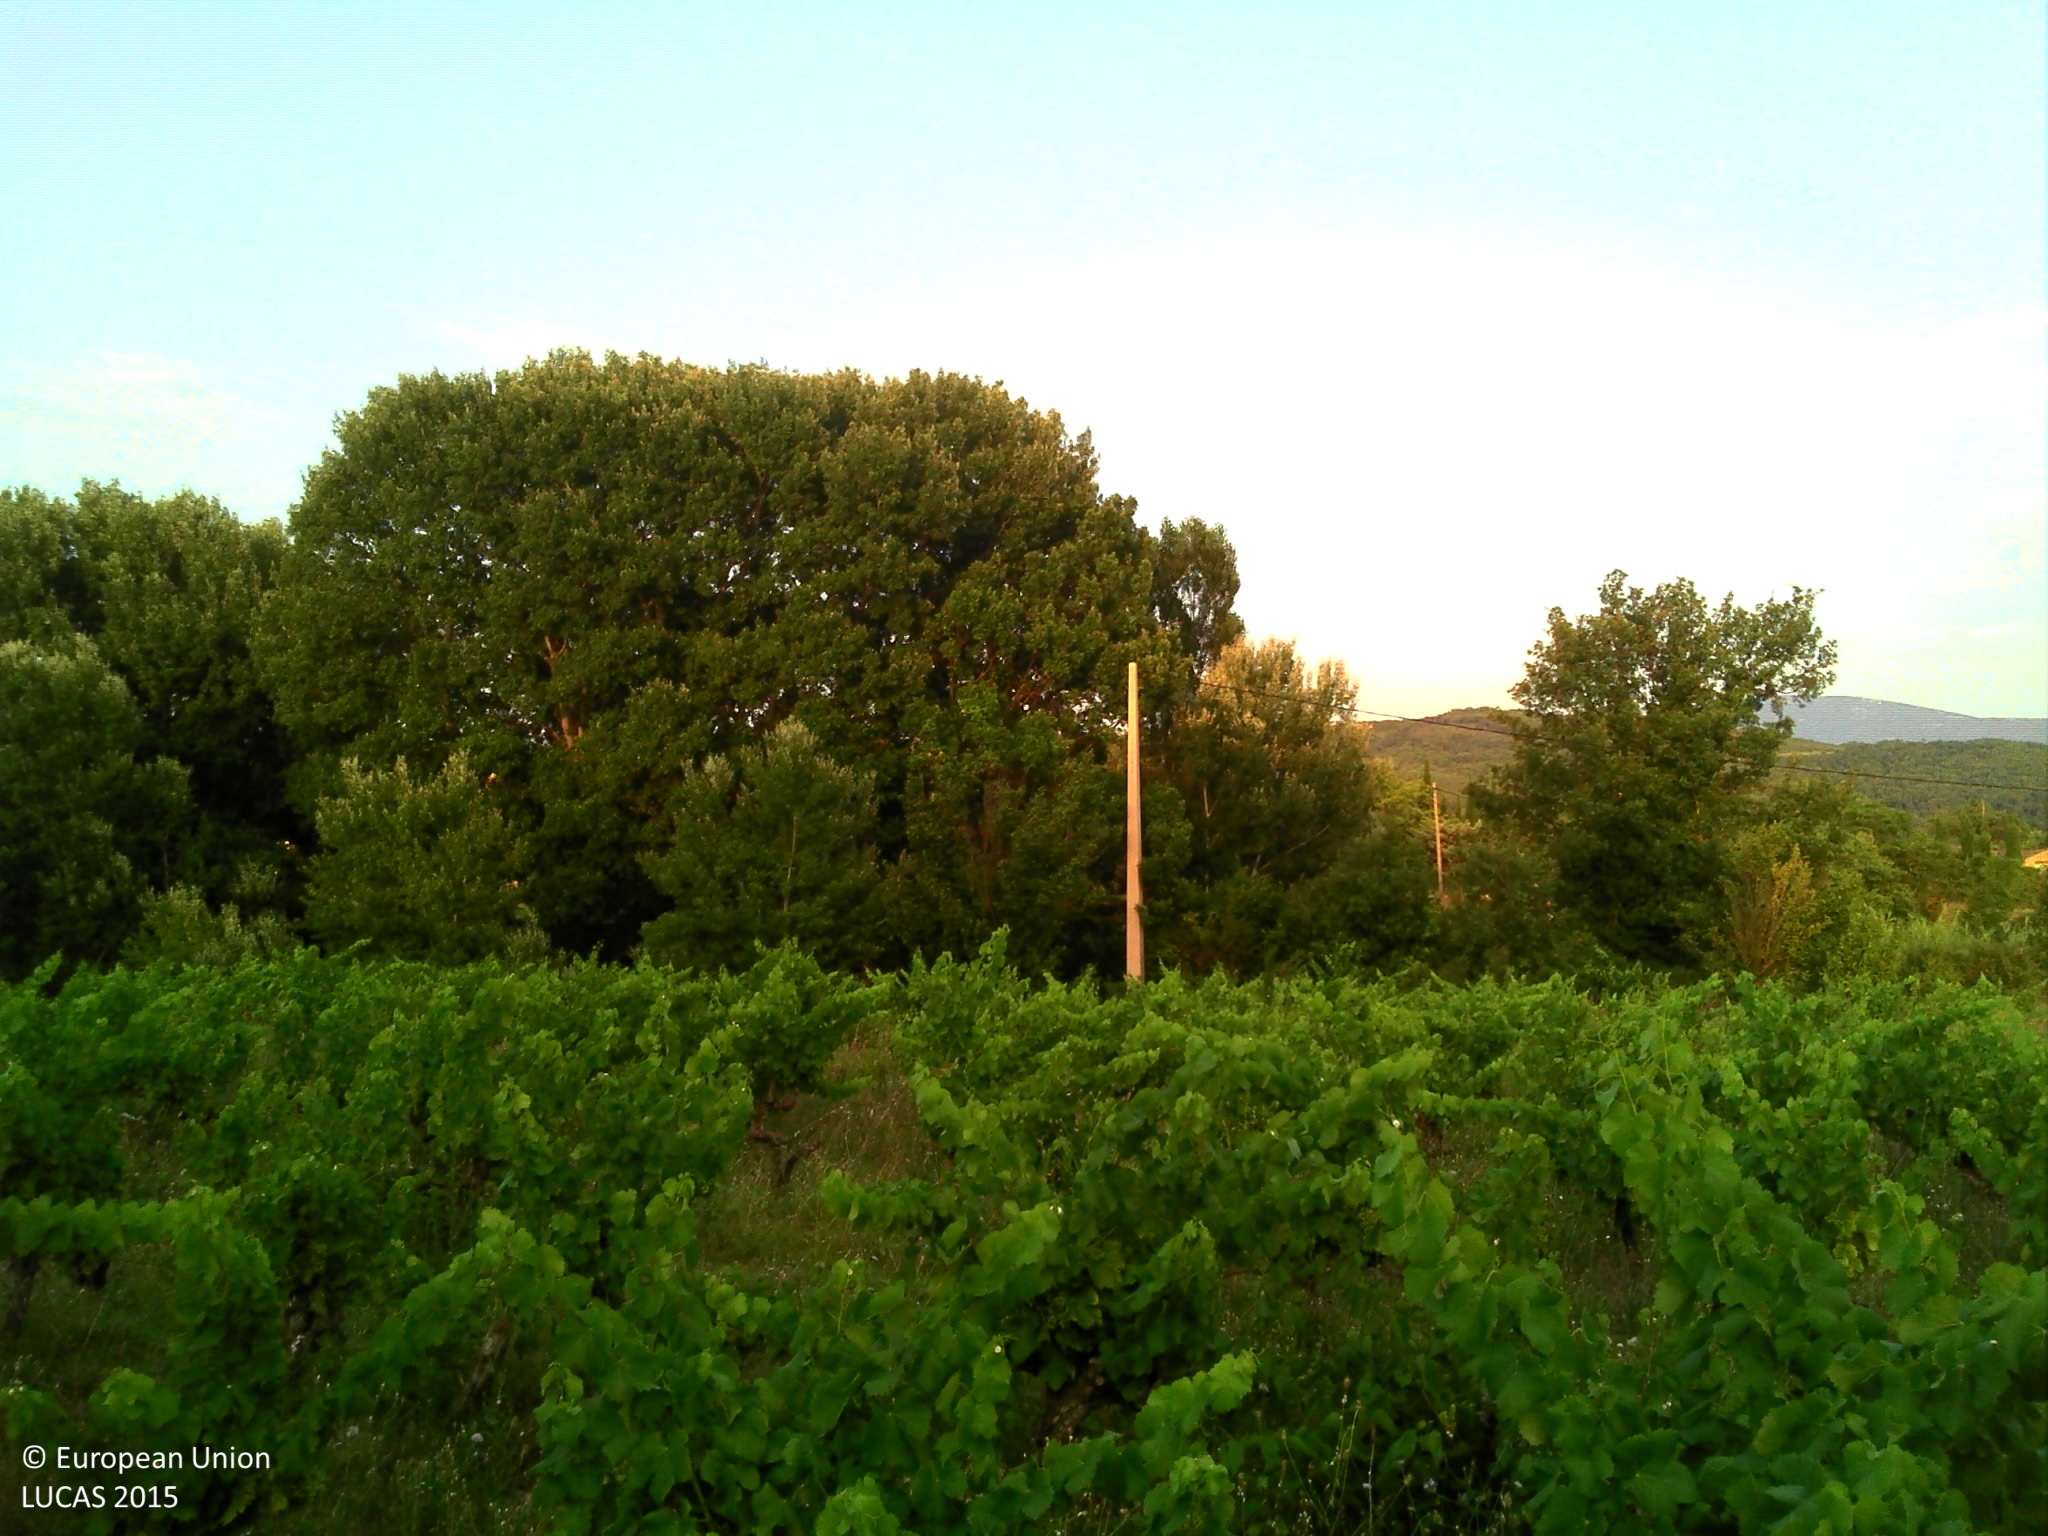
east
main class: Cropland
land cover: Vineyards
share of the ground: > 75 %
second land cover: Spontaneously vegetated surfaces
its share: > 75 %
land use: Agriculture (excluding fallow land and kitchen gardens)
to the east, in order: Vineyards; Spontaneously vegetated surfaces; Electric lines; Lines of trees; Grass margins; Broadleaved woodland; Ditches and canals; Broadleaved woodland; Vineyards; Artificial constructions in urban areas; Vineyards; Grassland with sparse tree/shrub cover; Dry stone walls; Managed hedges; Vineyards
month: July
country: FR
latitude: 44.2522
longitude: 5.0857
